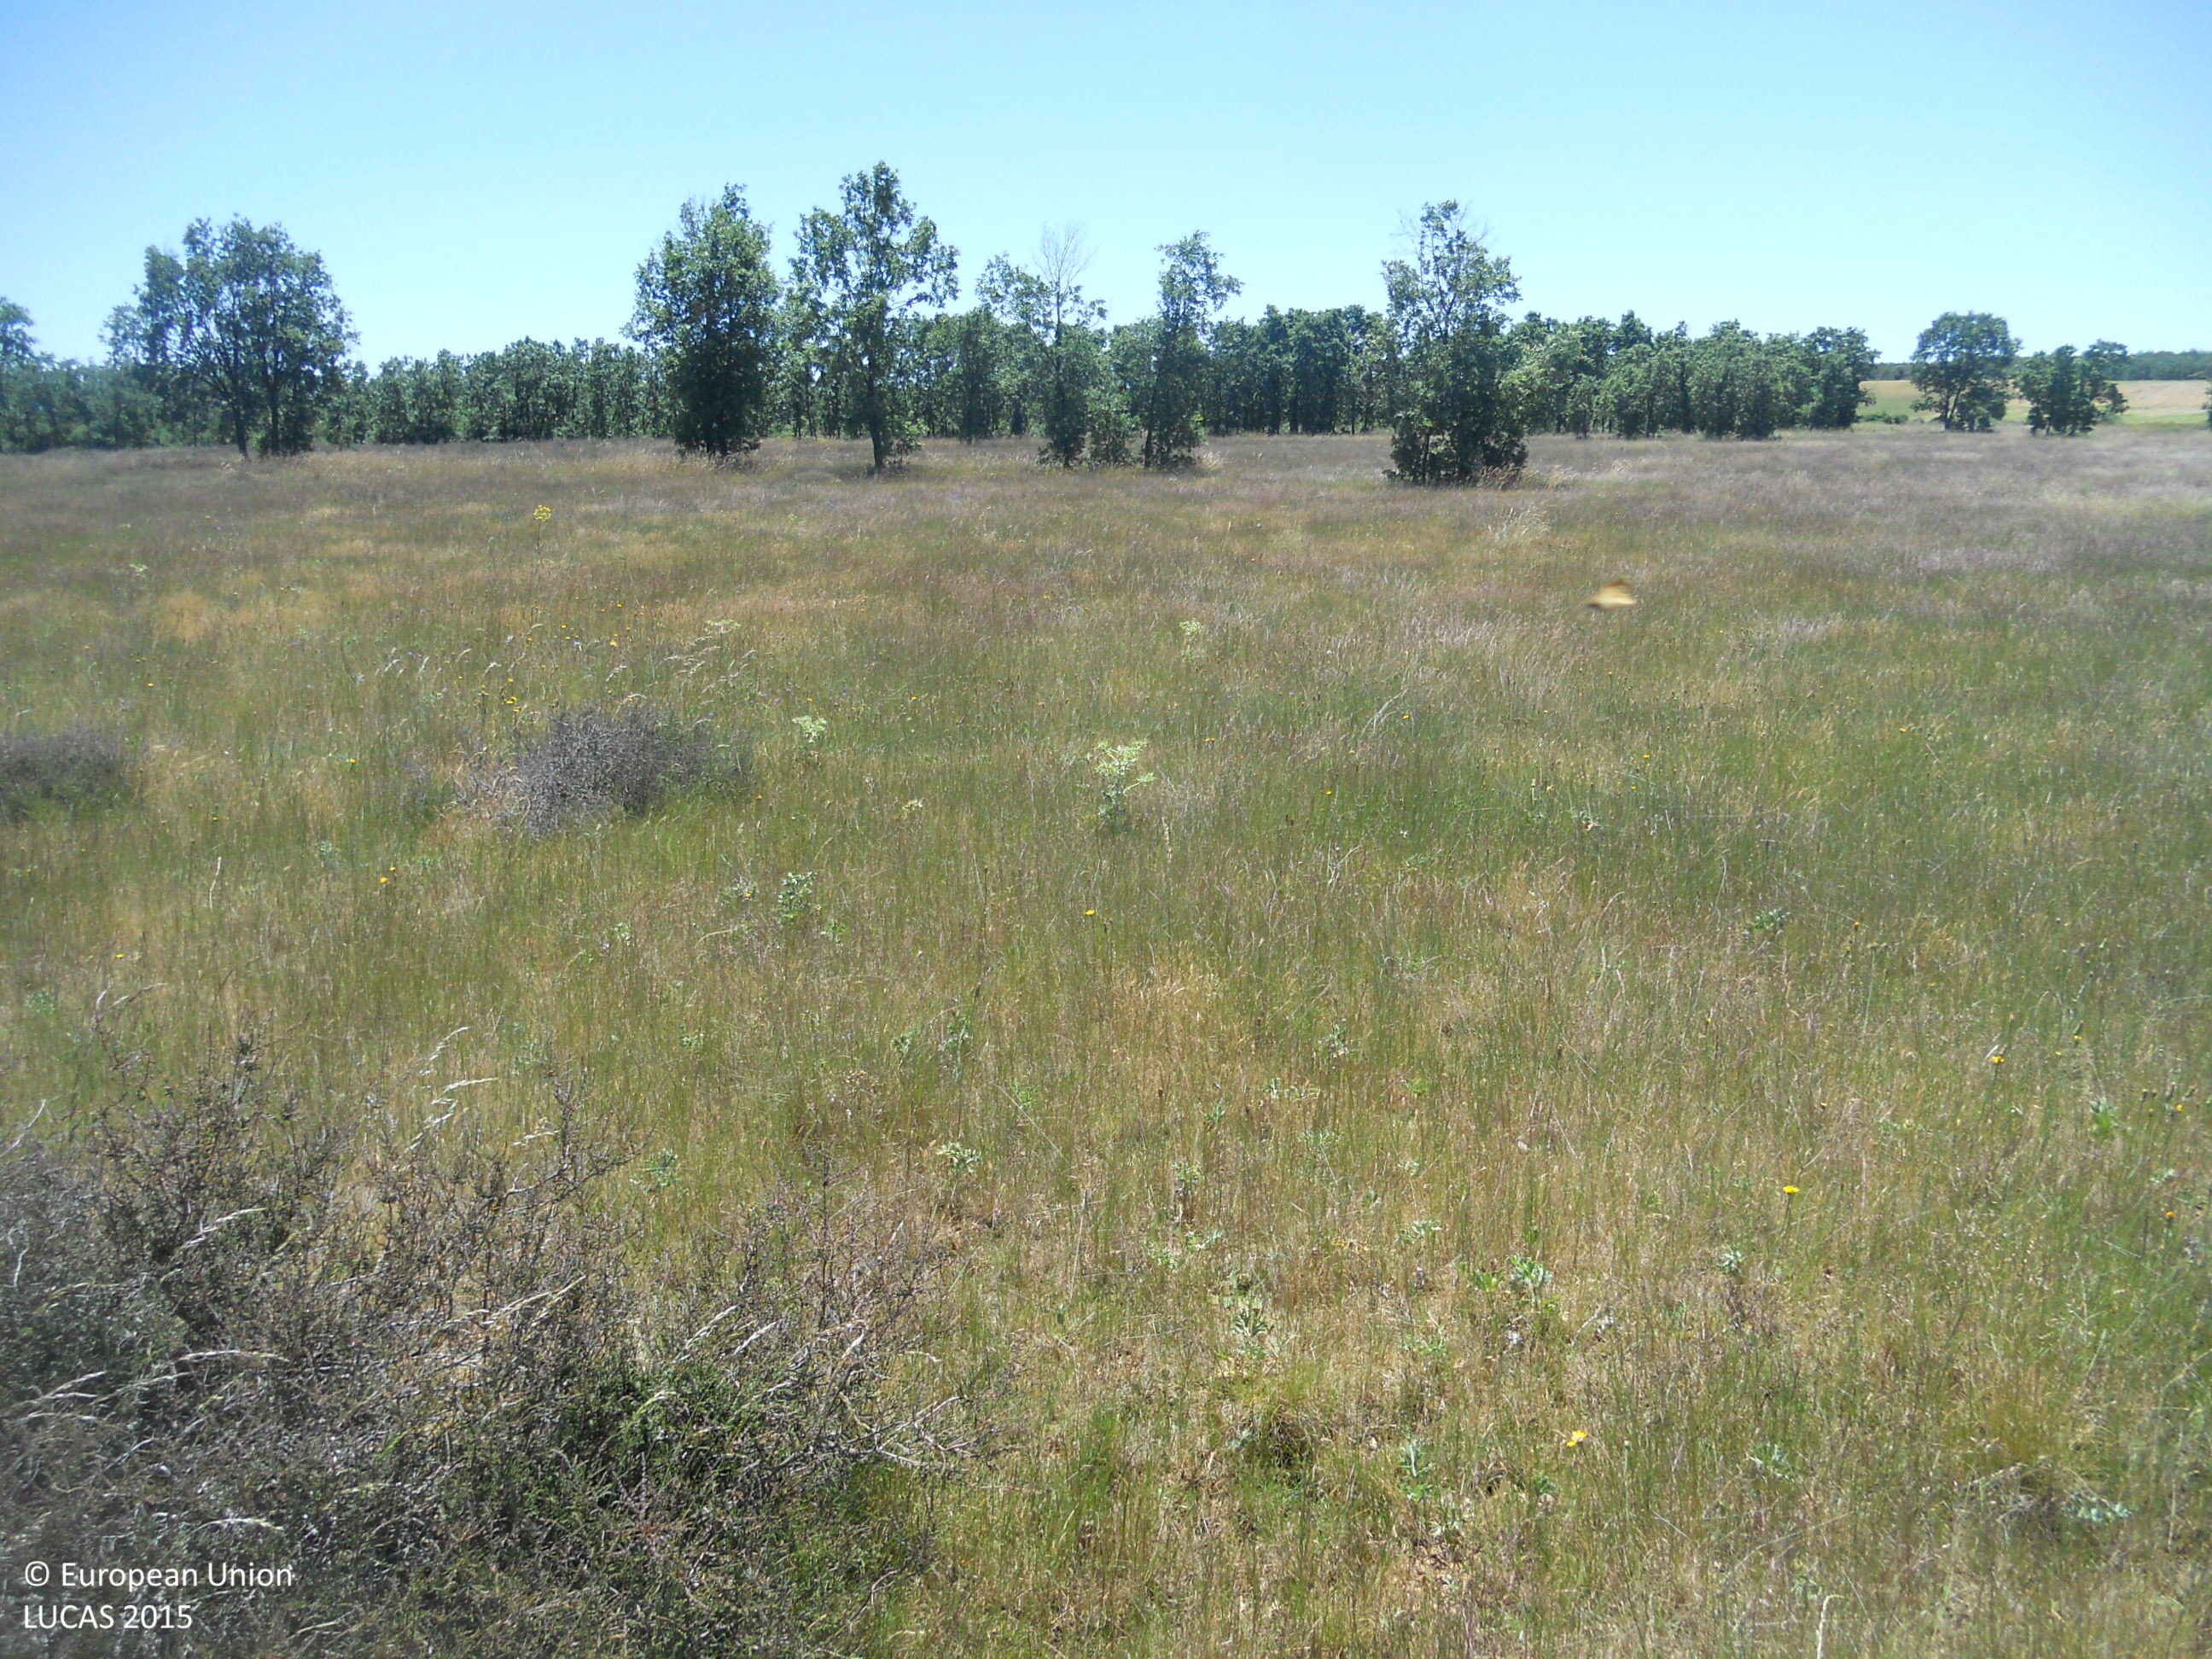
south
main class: Grassland
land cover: Grassland without tree/shrub cover
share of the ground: > 75 %
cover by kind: herbaceous plants 95 %, shrubs 5 %
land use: Forestry
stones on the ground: > 50 %
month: June
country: ES
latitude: 42.4888
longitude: -4.8392
